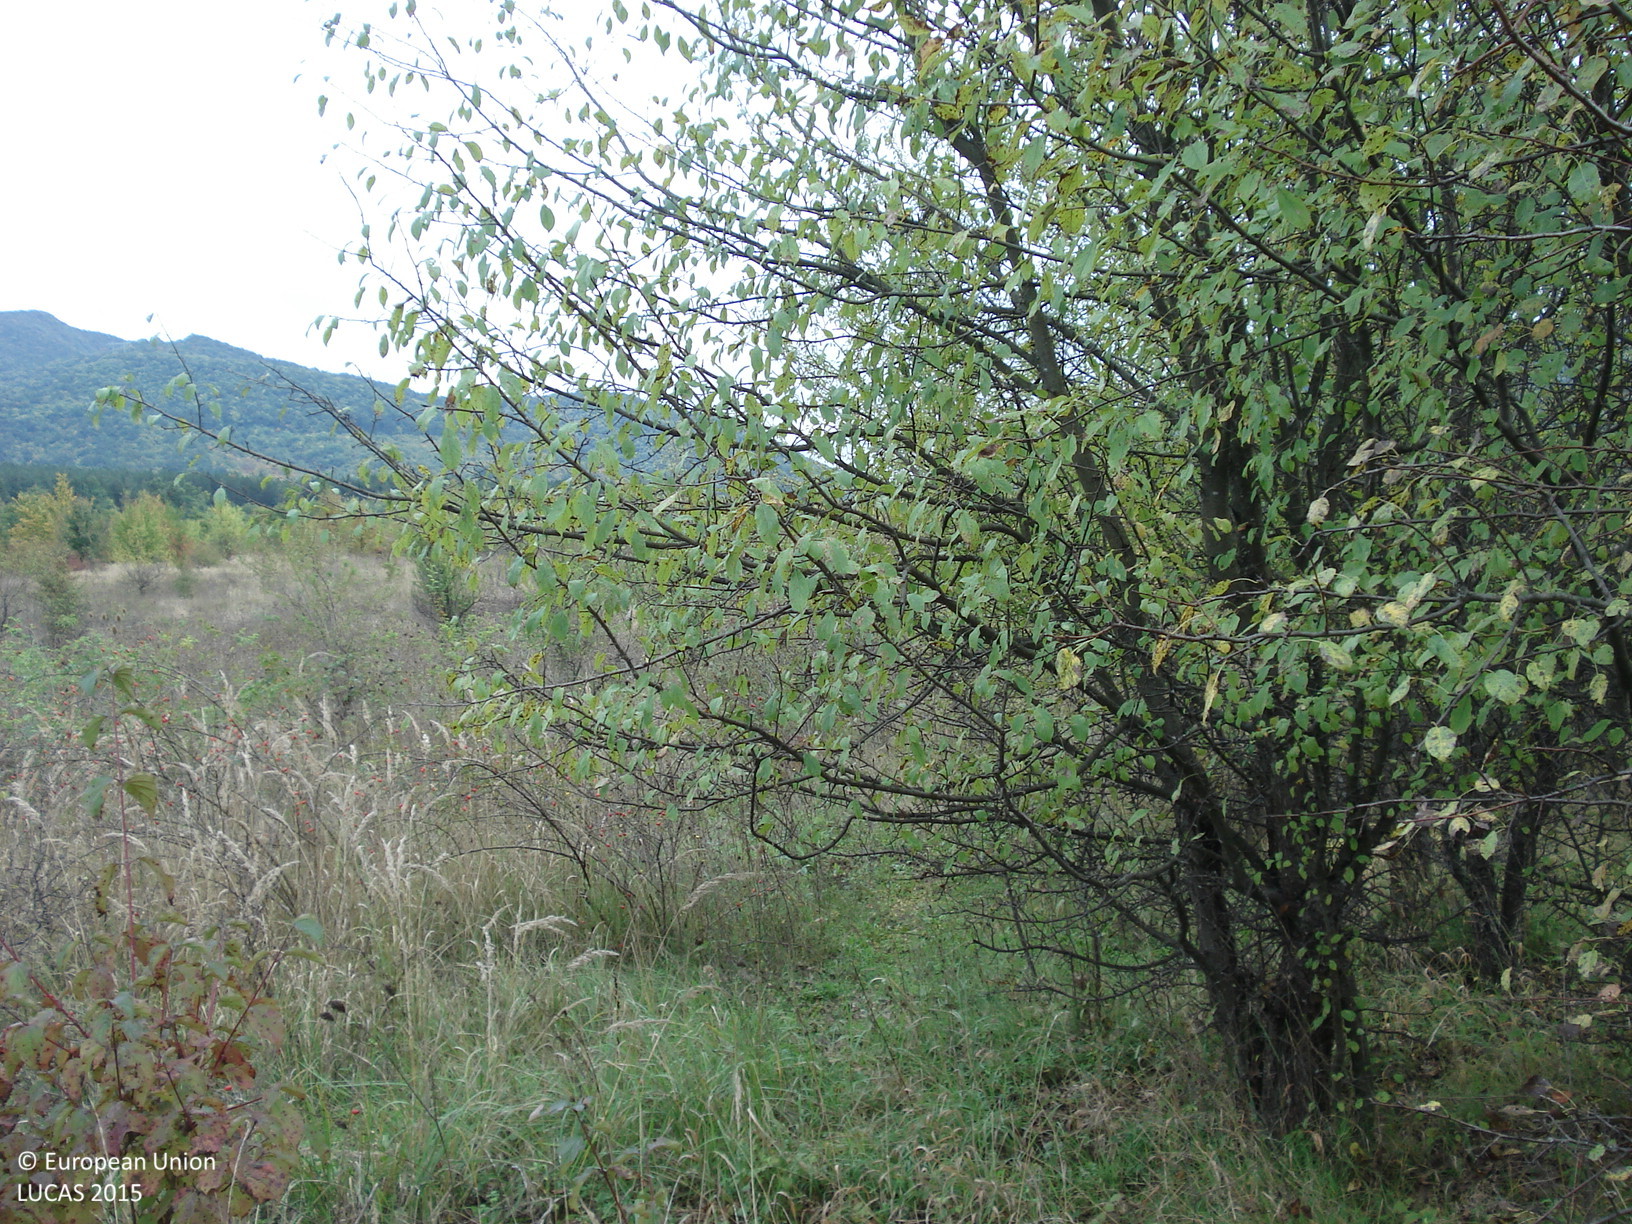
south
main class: Woodland
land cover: Broadleaved woodland
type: mesophytic deciduous forest
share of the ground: > 75 %
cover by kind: broadleaved forest trees 80 %, shrubs 10 %, herbaceous plants 10 %
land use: Forestry
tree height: > 5 m
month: October
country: BG
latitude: 42.9928
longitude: 25.7439
